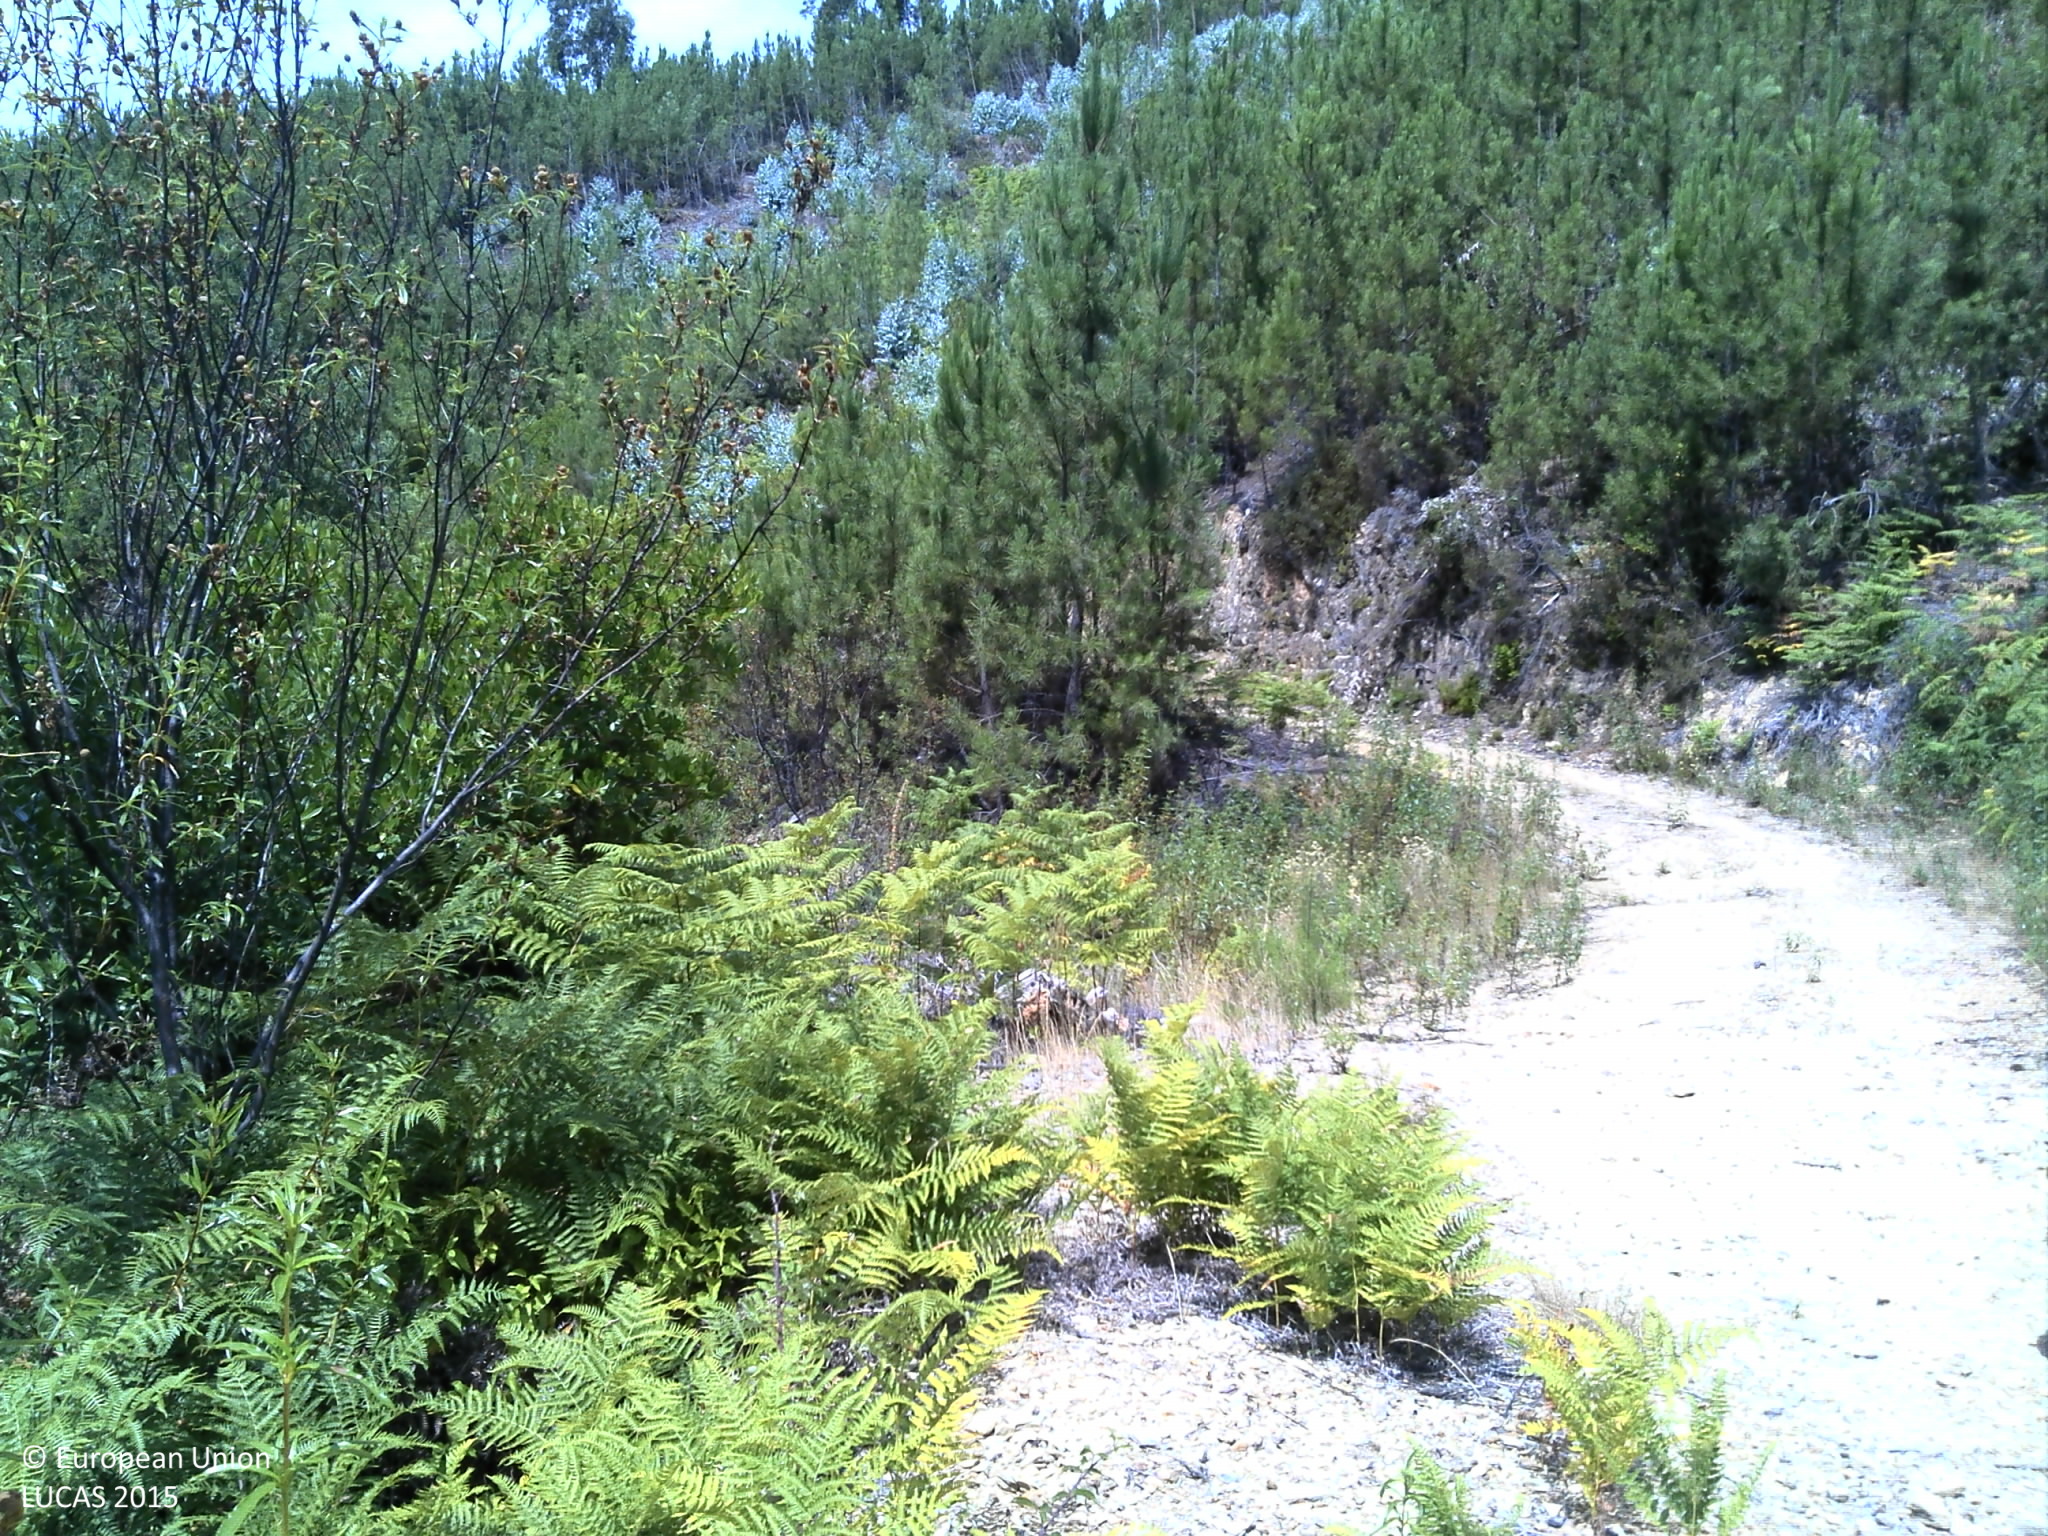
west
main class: Woodland
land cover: Pine dominated coniferous woodland
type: coniferous forest of the mediterranean region
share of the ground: 25 - 50 %
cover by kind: shrubs 50 %, coniferous forest trees 30 %, unconsolidated bare surface 20 %
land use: Forestry
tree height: < 5 m
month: July
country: PT
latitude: 39.8417
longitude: -7.8121
